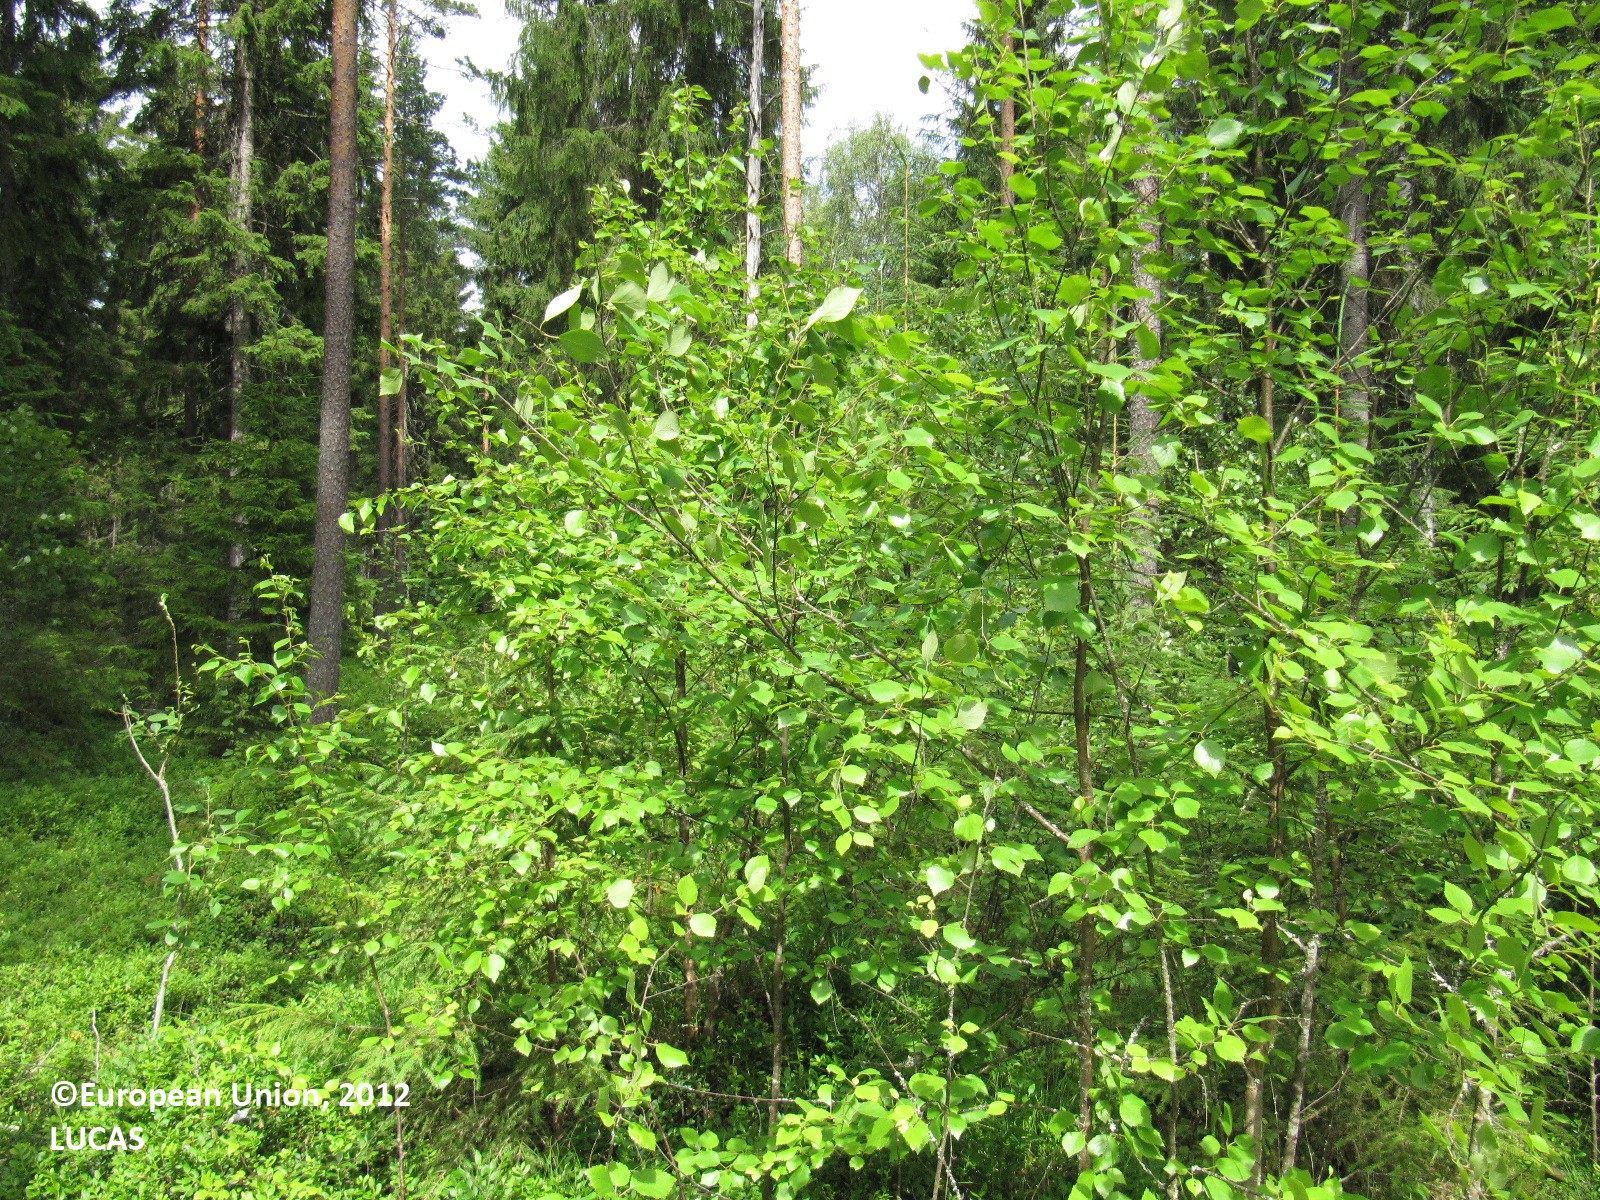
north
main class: Woodland
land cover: Other coniferous woodland
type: boreal forest
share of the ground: > 75 %
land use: Forestry
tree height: > 5 m
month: July
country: FI
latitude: 60.9864
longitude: 23.3702
